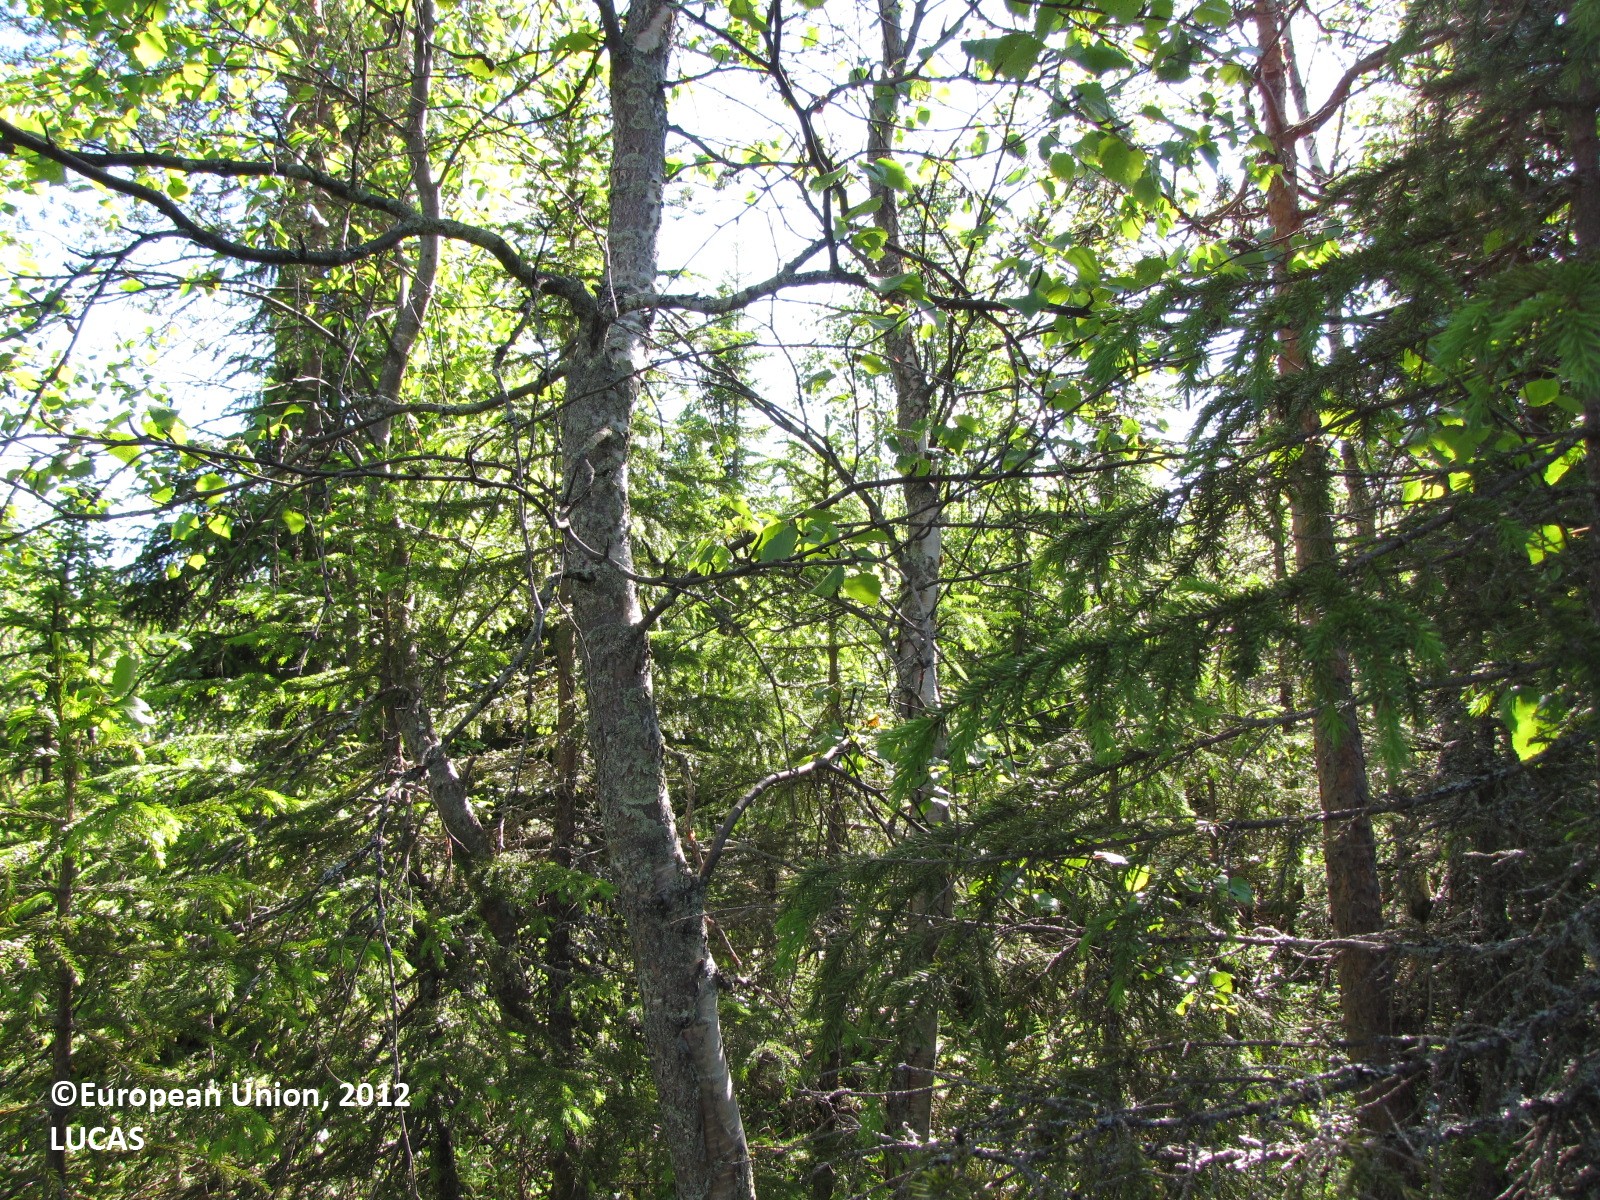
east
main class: Woodland
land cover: Spruce dominated mixed woodland
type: boreal forest
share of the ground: 10 - 25 %
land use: Forestry
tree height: > 5 m
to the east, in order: Spruce dominated mixed woodland; Broadleaved woodland; Spruce dominated mixed woodland; Other mixed woodland; Ditches and canals; Shruby margins; Tracks; Shruby margins; Other mixed woodland; Pine dominated coniferous woodland
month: July
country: FI
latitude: 66.4308
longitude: 24.8207
